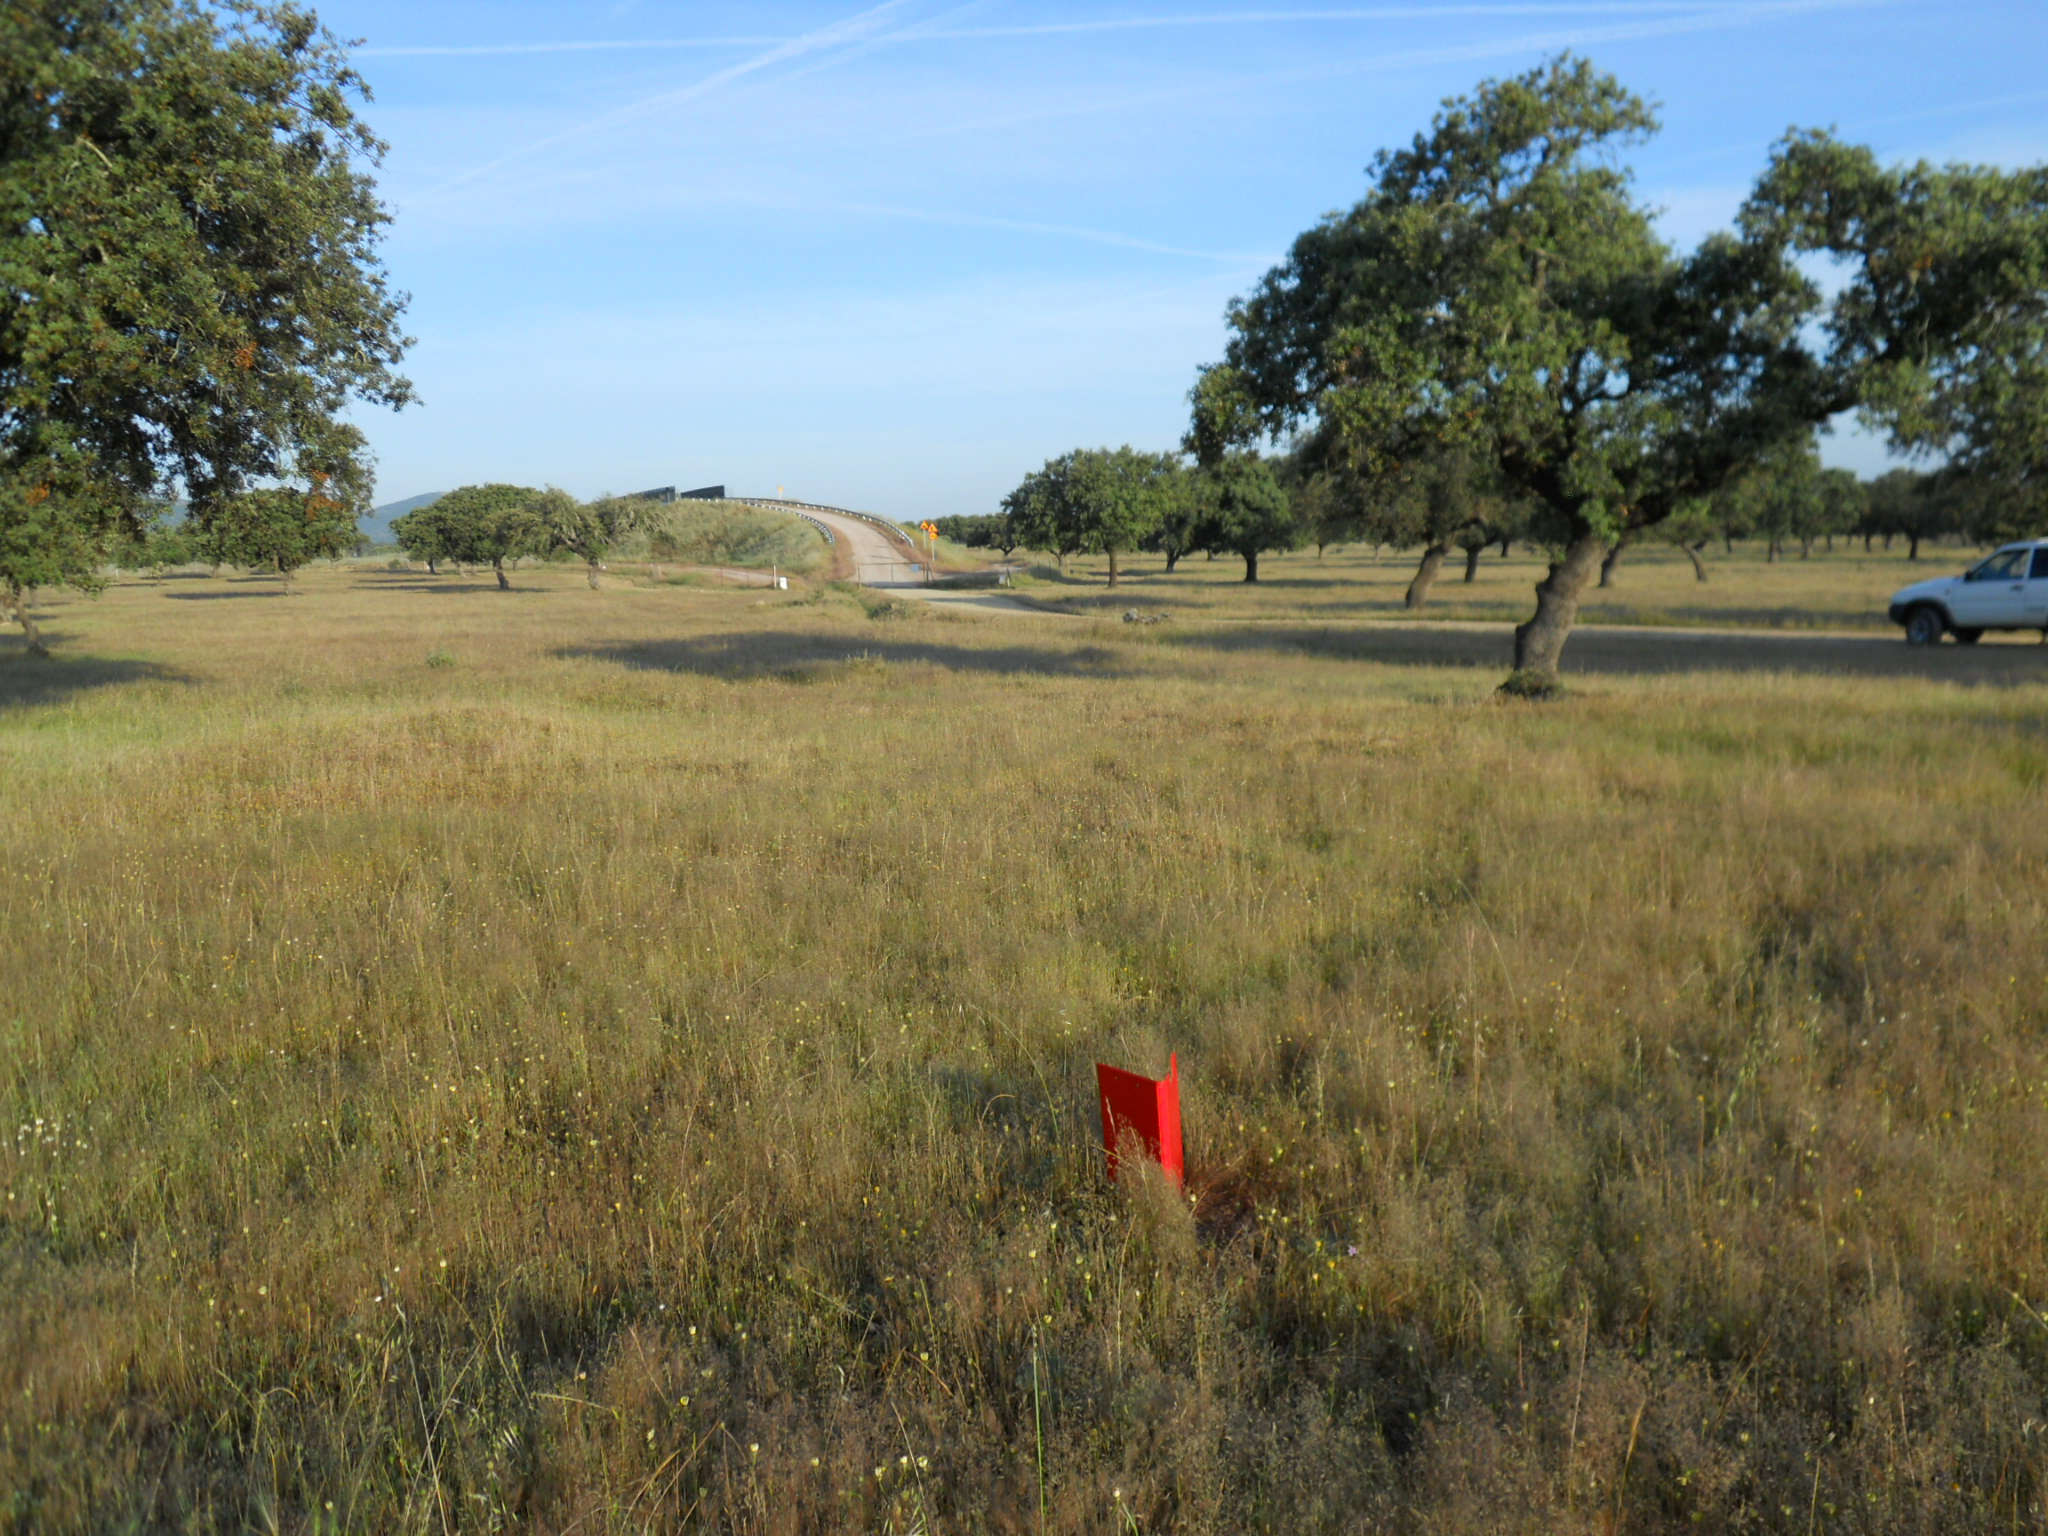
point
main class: Woodland
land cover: Broadleaved woodland
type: broadleaved evergreen forest
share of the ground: 10 - 25 %
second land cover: Grassland without tree/shrub cover
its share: > 75 %
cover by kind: herbaceous plants 80 %, broadleaved forest trees 20 %
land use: Forestry
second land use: Agriculture (excluding fallow land and kitchen gardens)
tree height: > 5 m
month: May
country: ES
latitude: 39.2682
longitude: -6.3723
